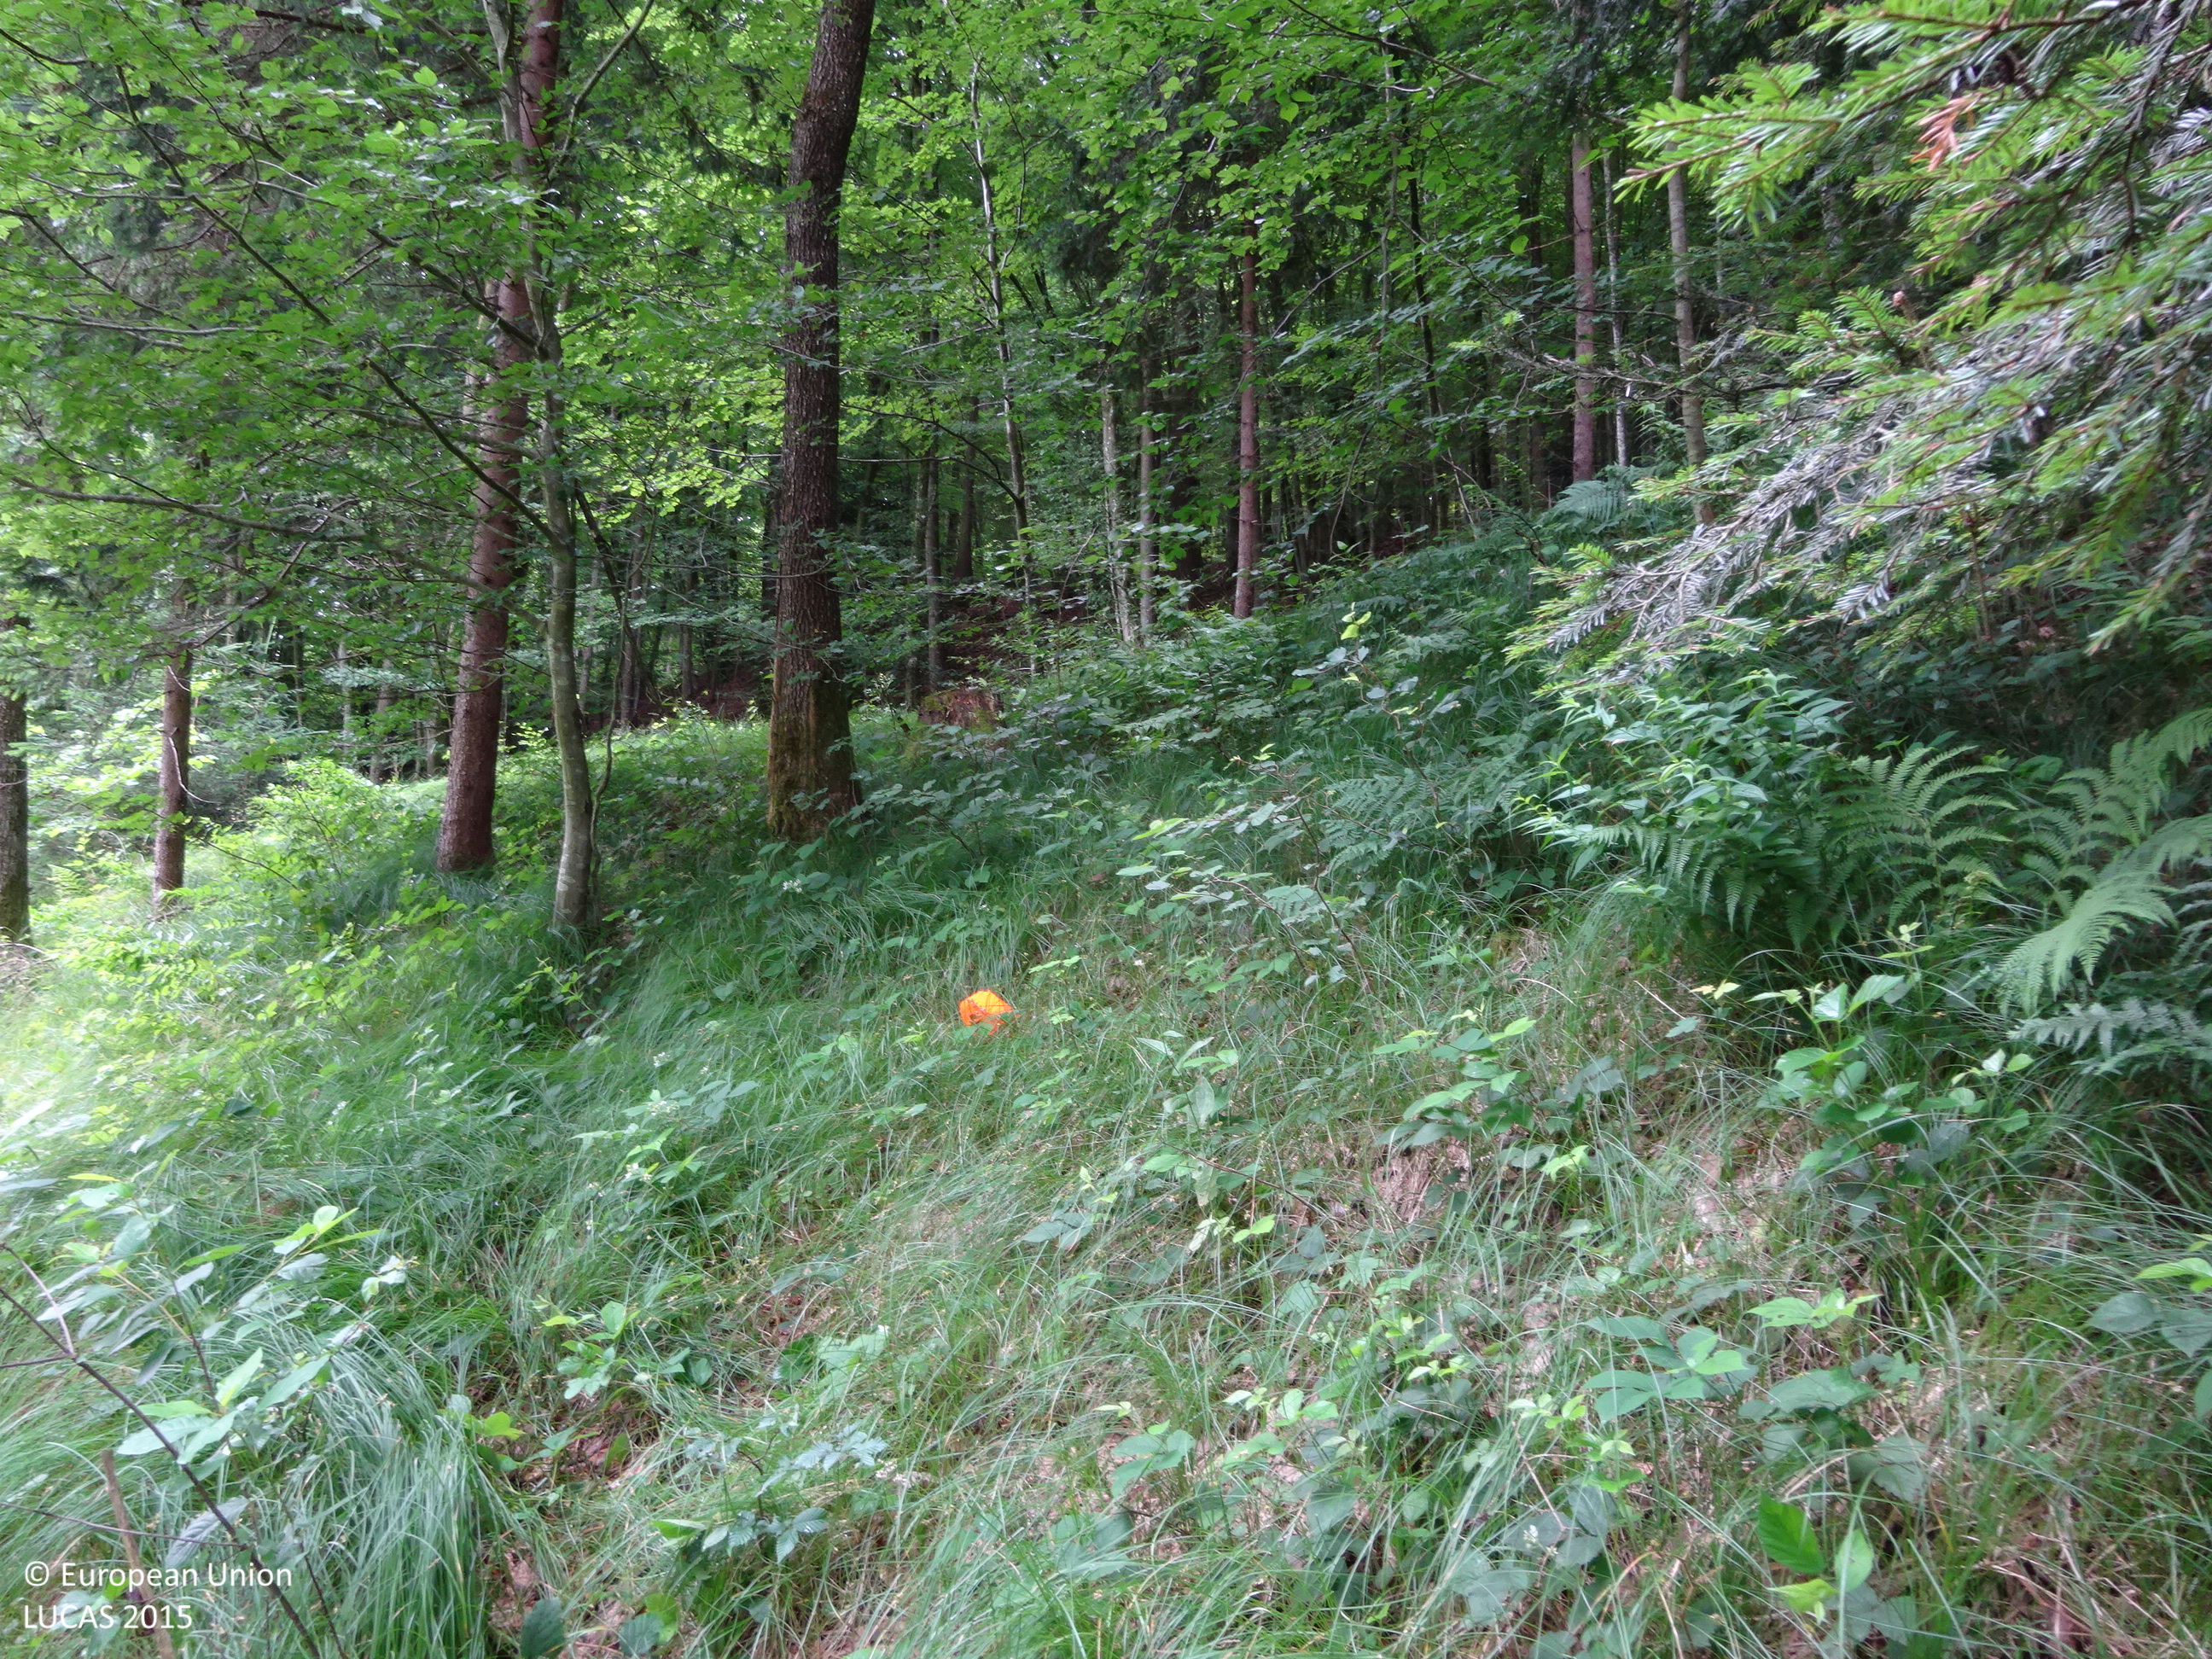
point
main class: Woodland
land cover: Spruce dominated mixed woodland
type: mountainous beech forest
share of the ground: > 75 %
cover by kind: broadleaved forest trees 75 %, coniferous forest trees 25 %
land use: Forestry
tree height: > 5 m
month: June
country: AT
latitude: 46.7533
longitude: 15.4582
